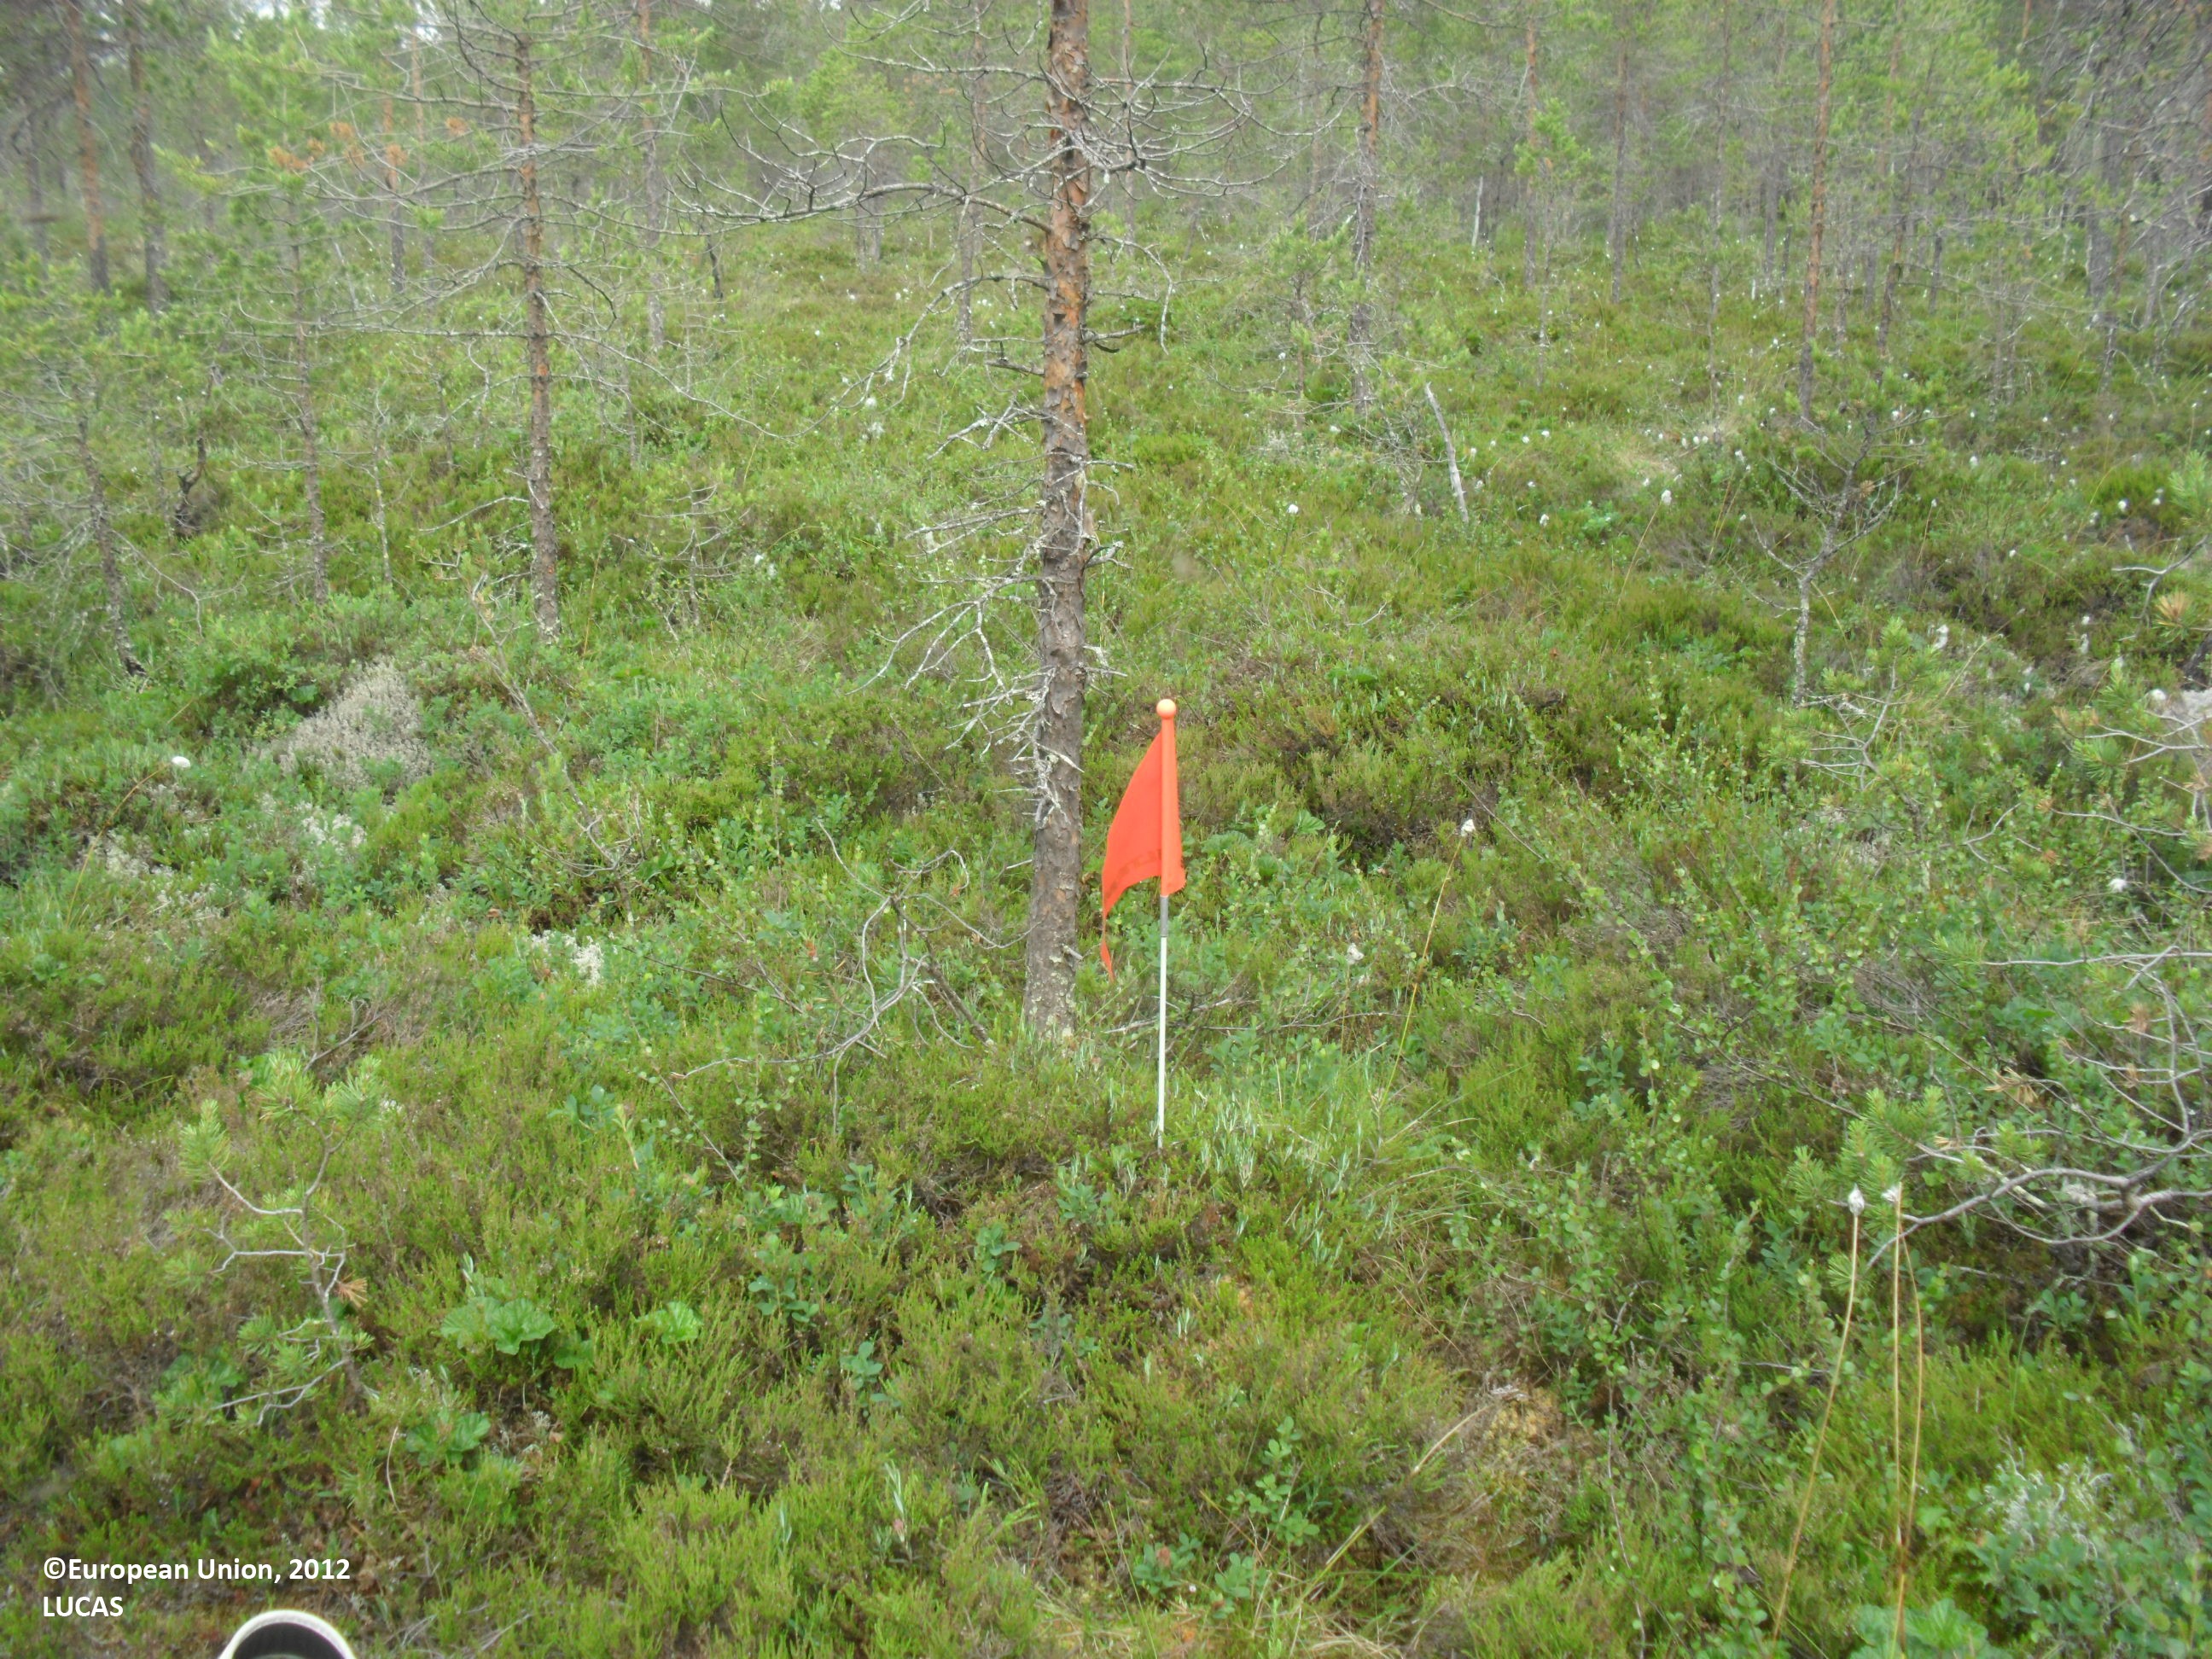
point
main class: Woodland
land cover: Pine dominated coniferous woodland
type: mire and swamp forests
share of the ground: 10 - 25 %
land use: Semi-natural and natural areas not in use
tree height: < 5 m
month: July
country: FI
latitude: 63.4878
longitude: 23.4950
